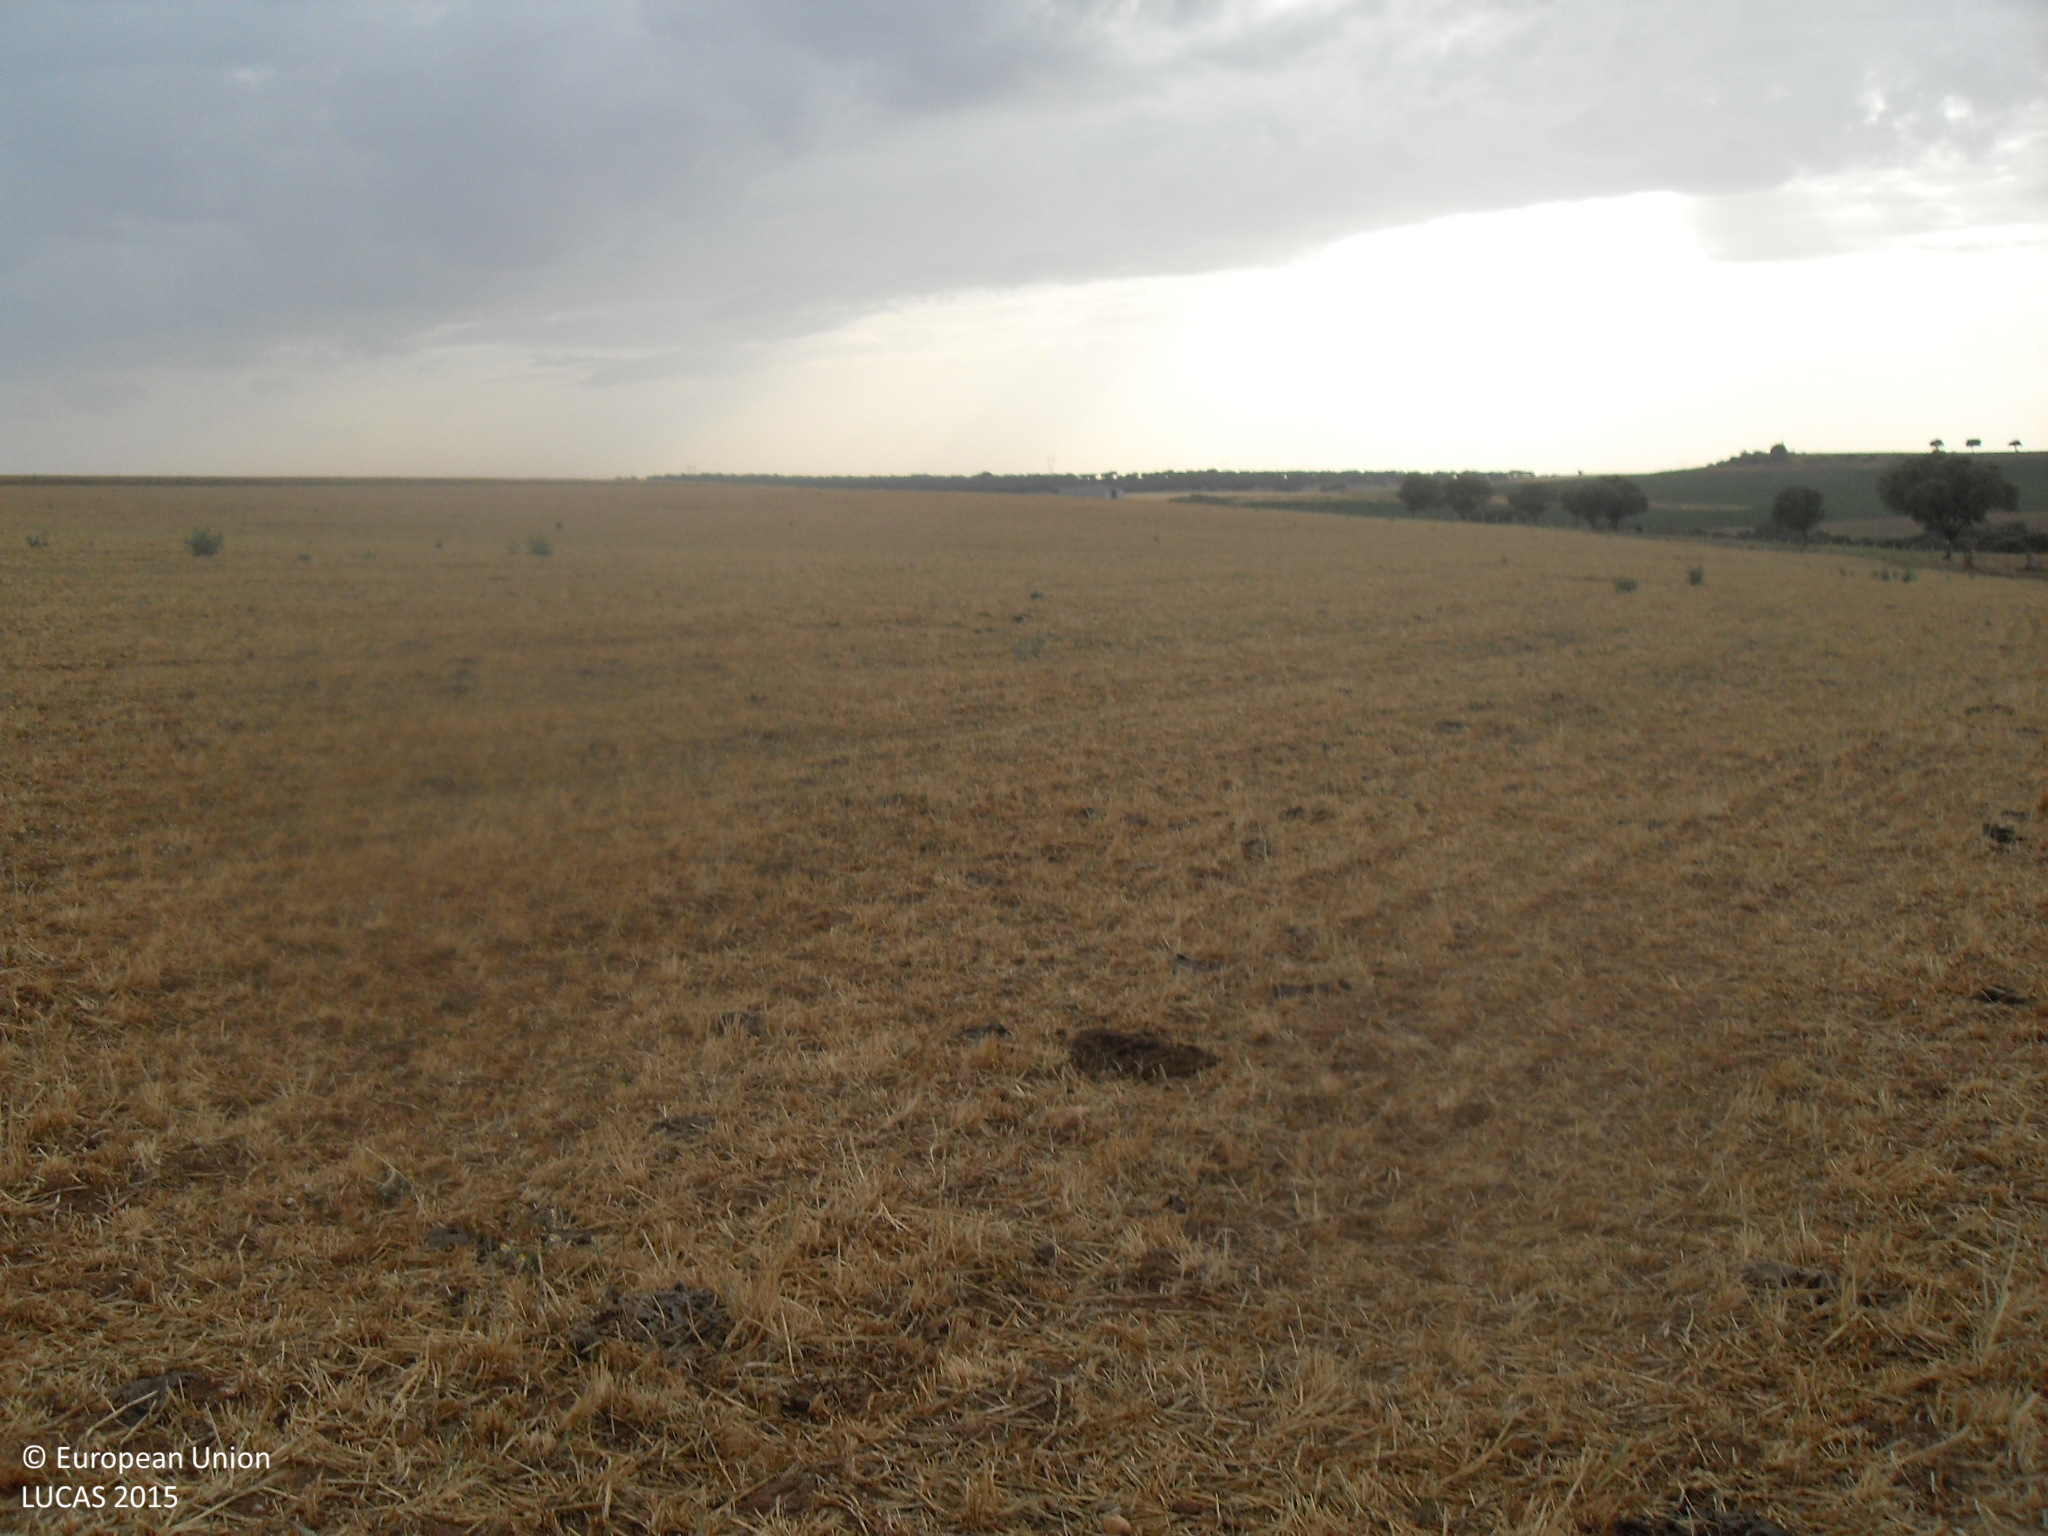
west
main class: Cropland
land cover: Rye
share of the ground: 10 - 25 %
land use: Agriculture (excluding fallow land and kitchen gardens)
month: June
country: ES
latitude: 41.0494
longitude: -5.7247
